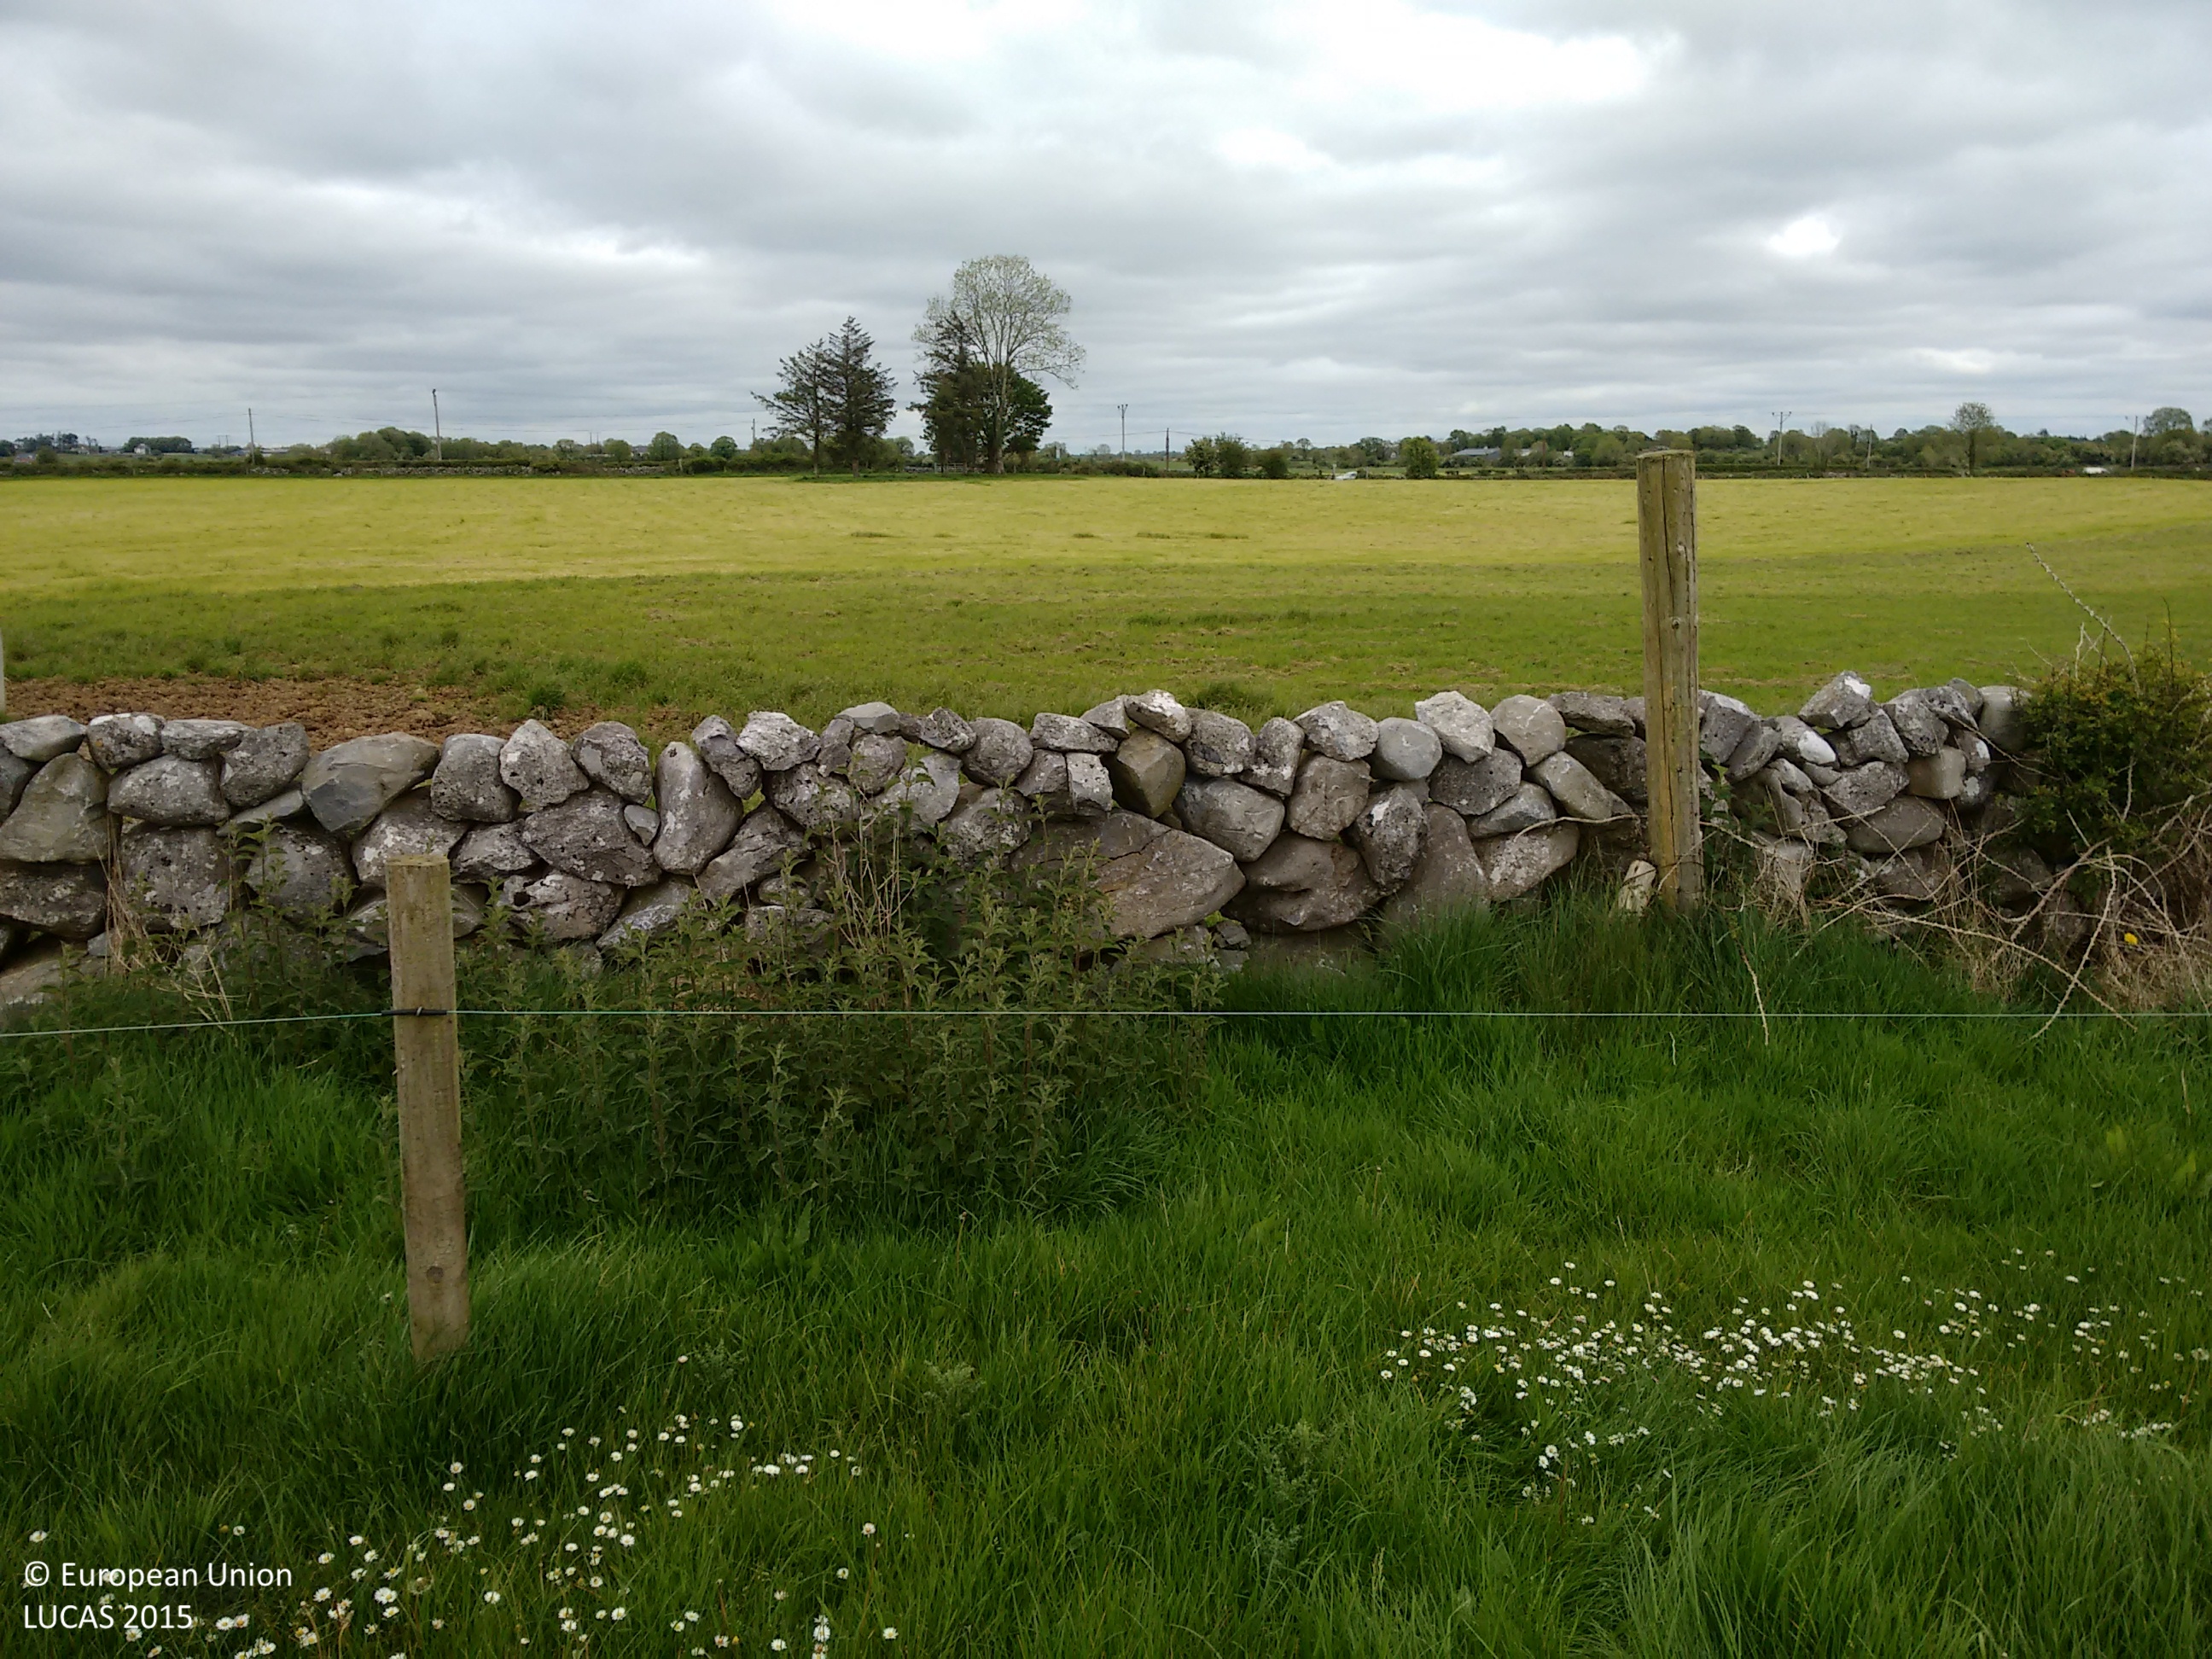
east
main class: Grassland
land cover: Grassland without tree/shrub cover
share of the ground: > 75 %
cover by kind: herbaceous plants 100 %
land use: Agriculture (excluding fallow land and kitchen gardens)
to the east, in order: Grassland without tree/shrub cover; Fences; Grassland without tree/shrub cover; Dry stone walls; Grassland without tree/shrub cover; Electric lines; Grassland without tree/shrub cover; Electric lines; Grassland without tree/shrub cover; Fences; Abandoned hedges; Dry stone walls; Abandoned hedges; Grass margins; Paved roads, cycling and walking lanes
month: May
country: IE
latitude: 53.2594
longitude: -8.6839
